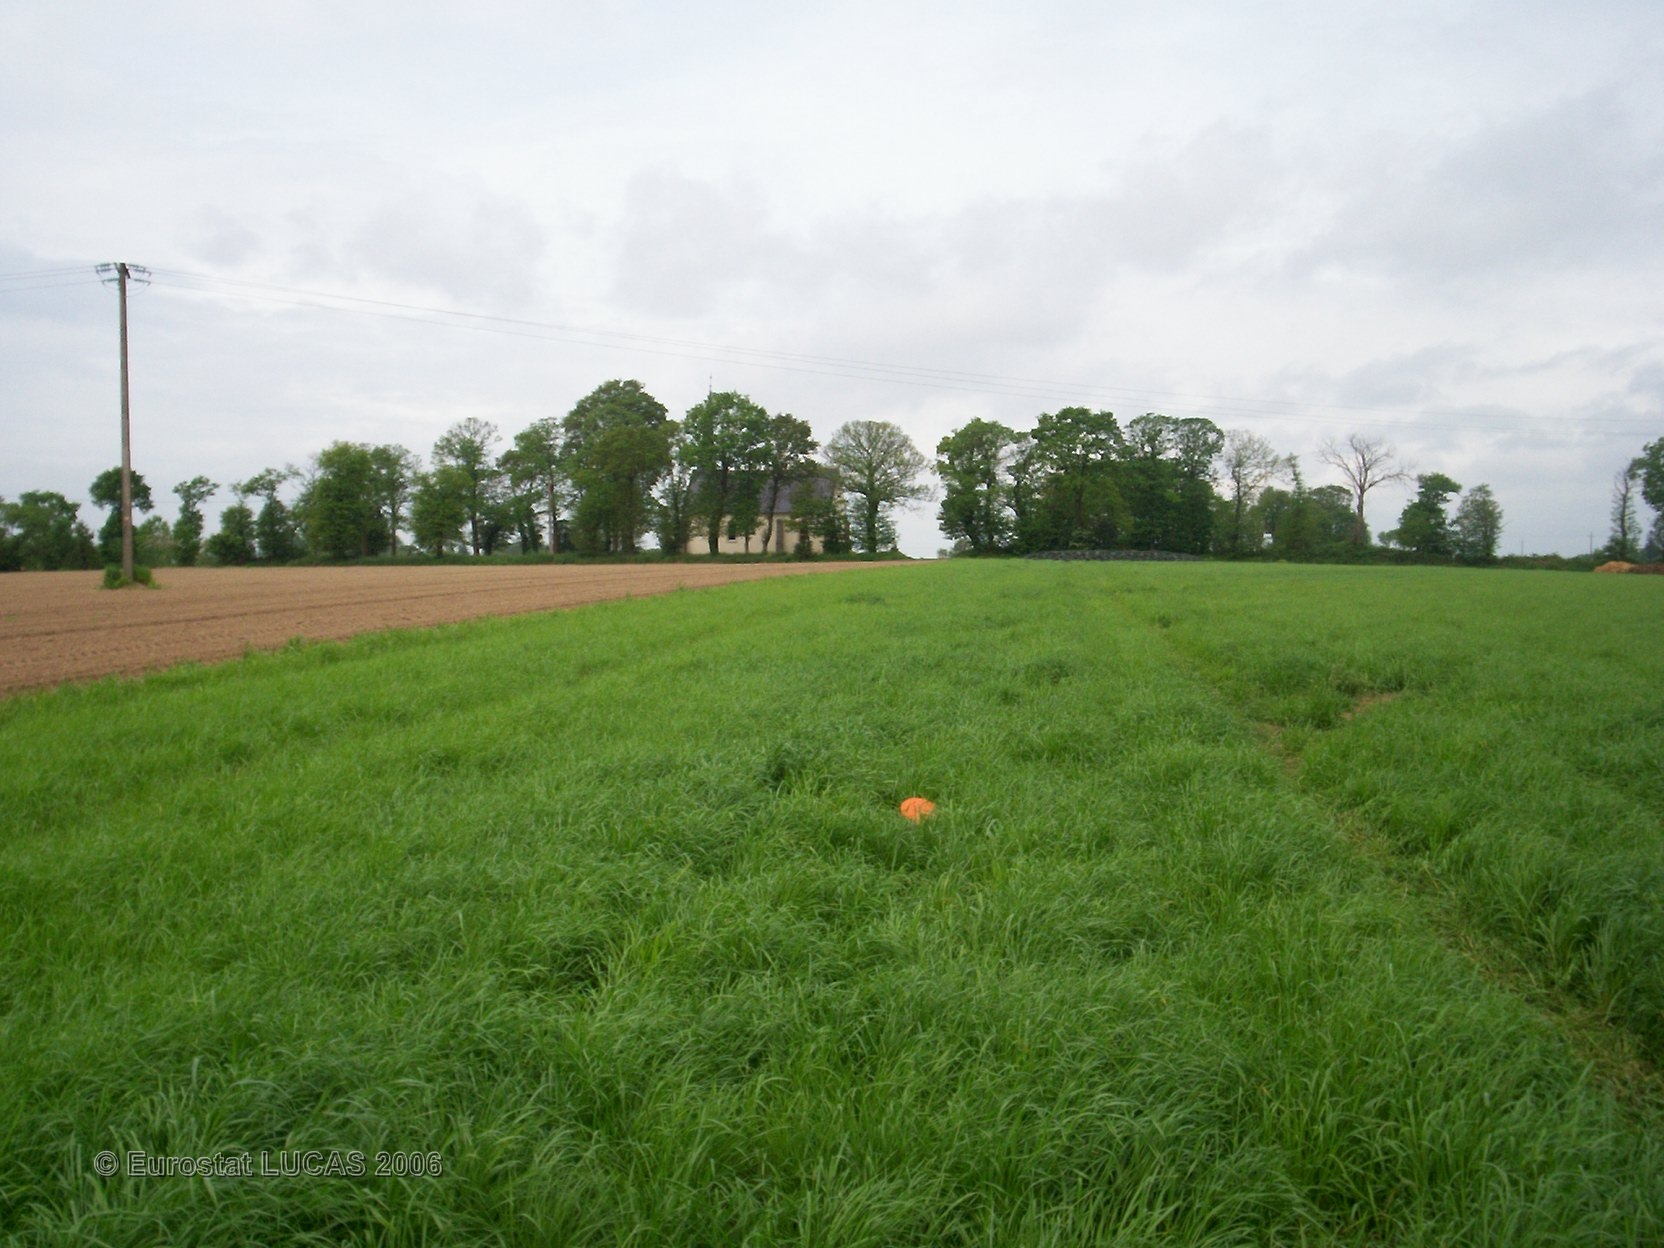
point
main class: Grassland
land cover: Grassland without tree/shrub cover
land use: Agriculture (excluding fallow land and kitchen gardens)
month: May
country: FR
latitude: 47.8519
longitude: -2.3654
